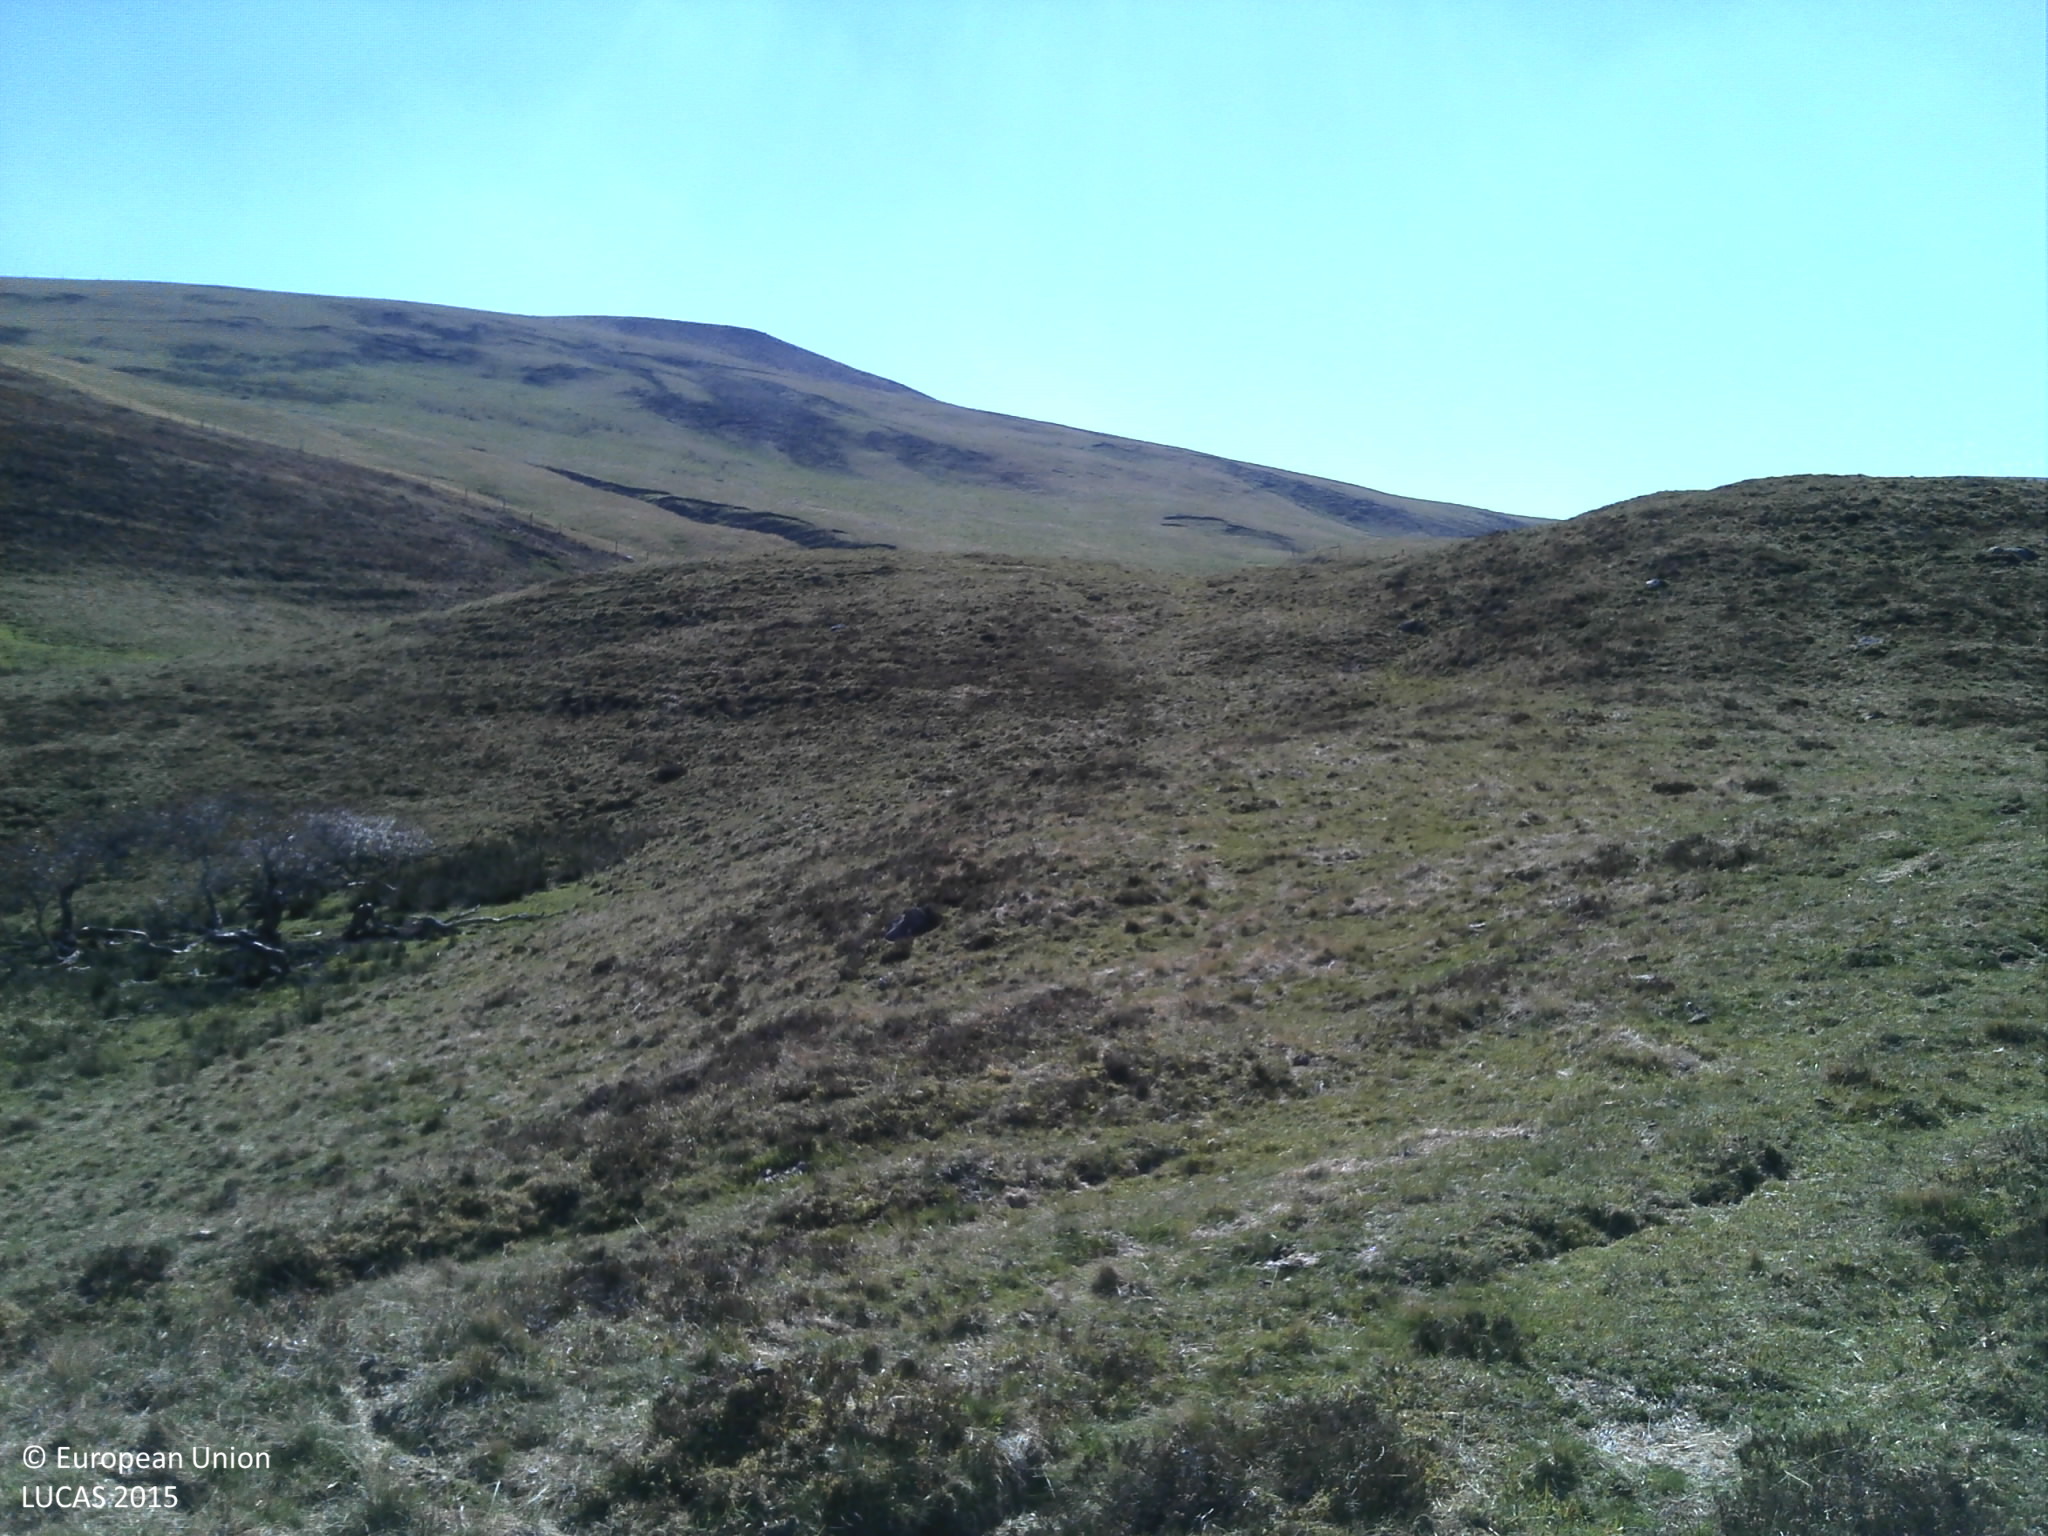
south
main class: Grassland
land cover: Grassland without tree/shrub cover
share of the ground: > 75 %
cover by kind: herbaceous plants 100 %
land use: Agriculture (excluding fallow land and kitchen gardens)
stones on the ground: < 10 %
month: October
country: FR
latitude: 45.3405
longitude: 2.9435
